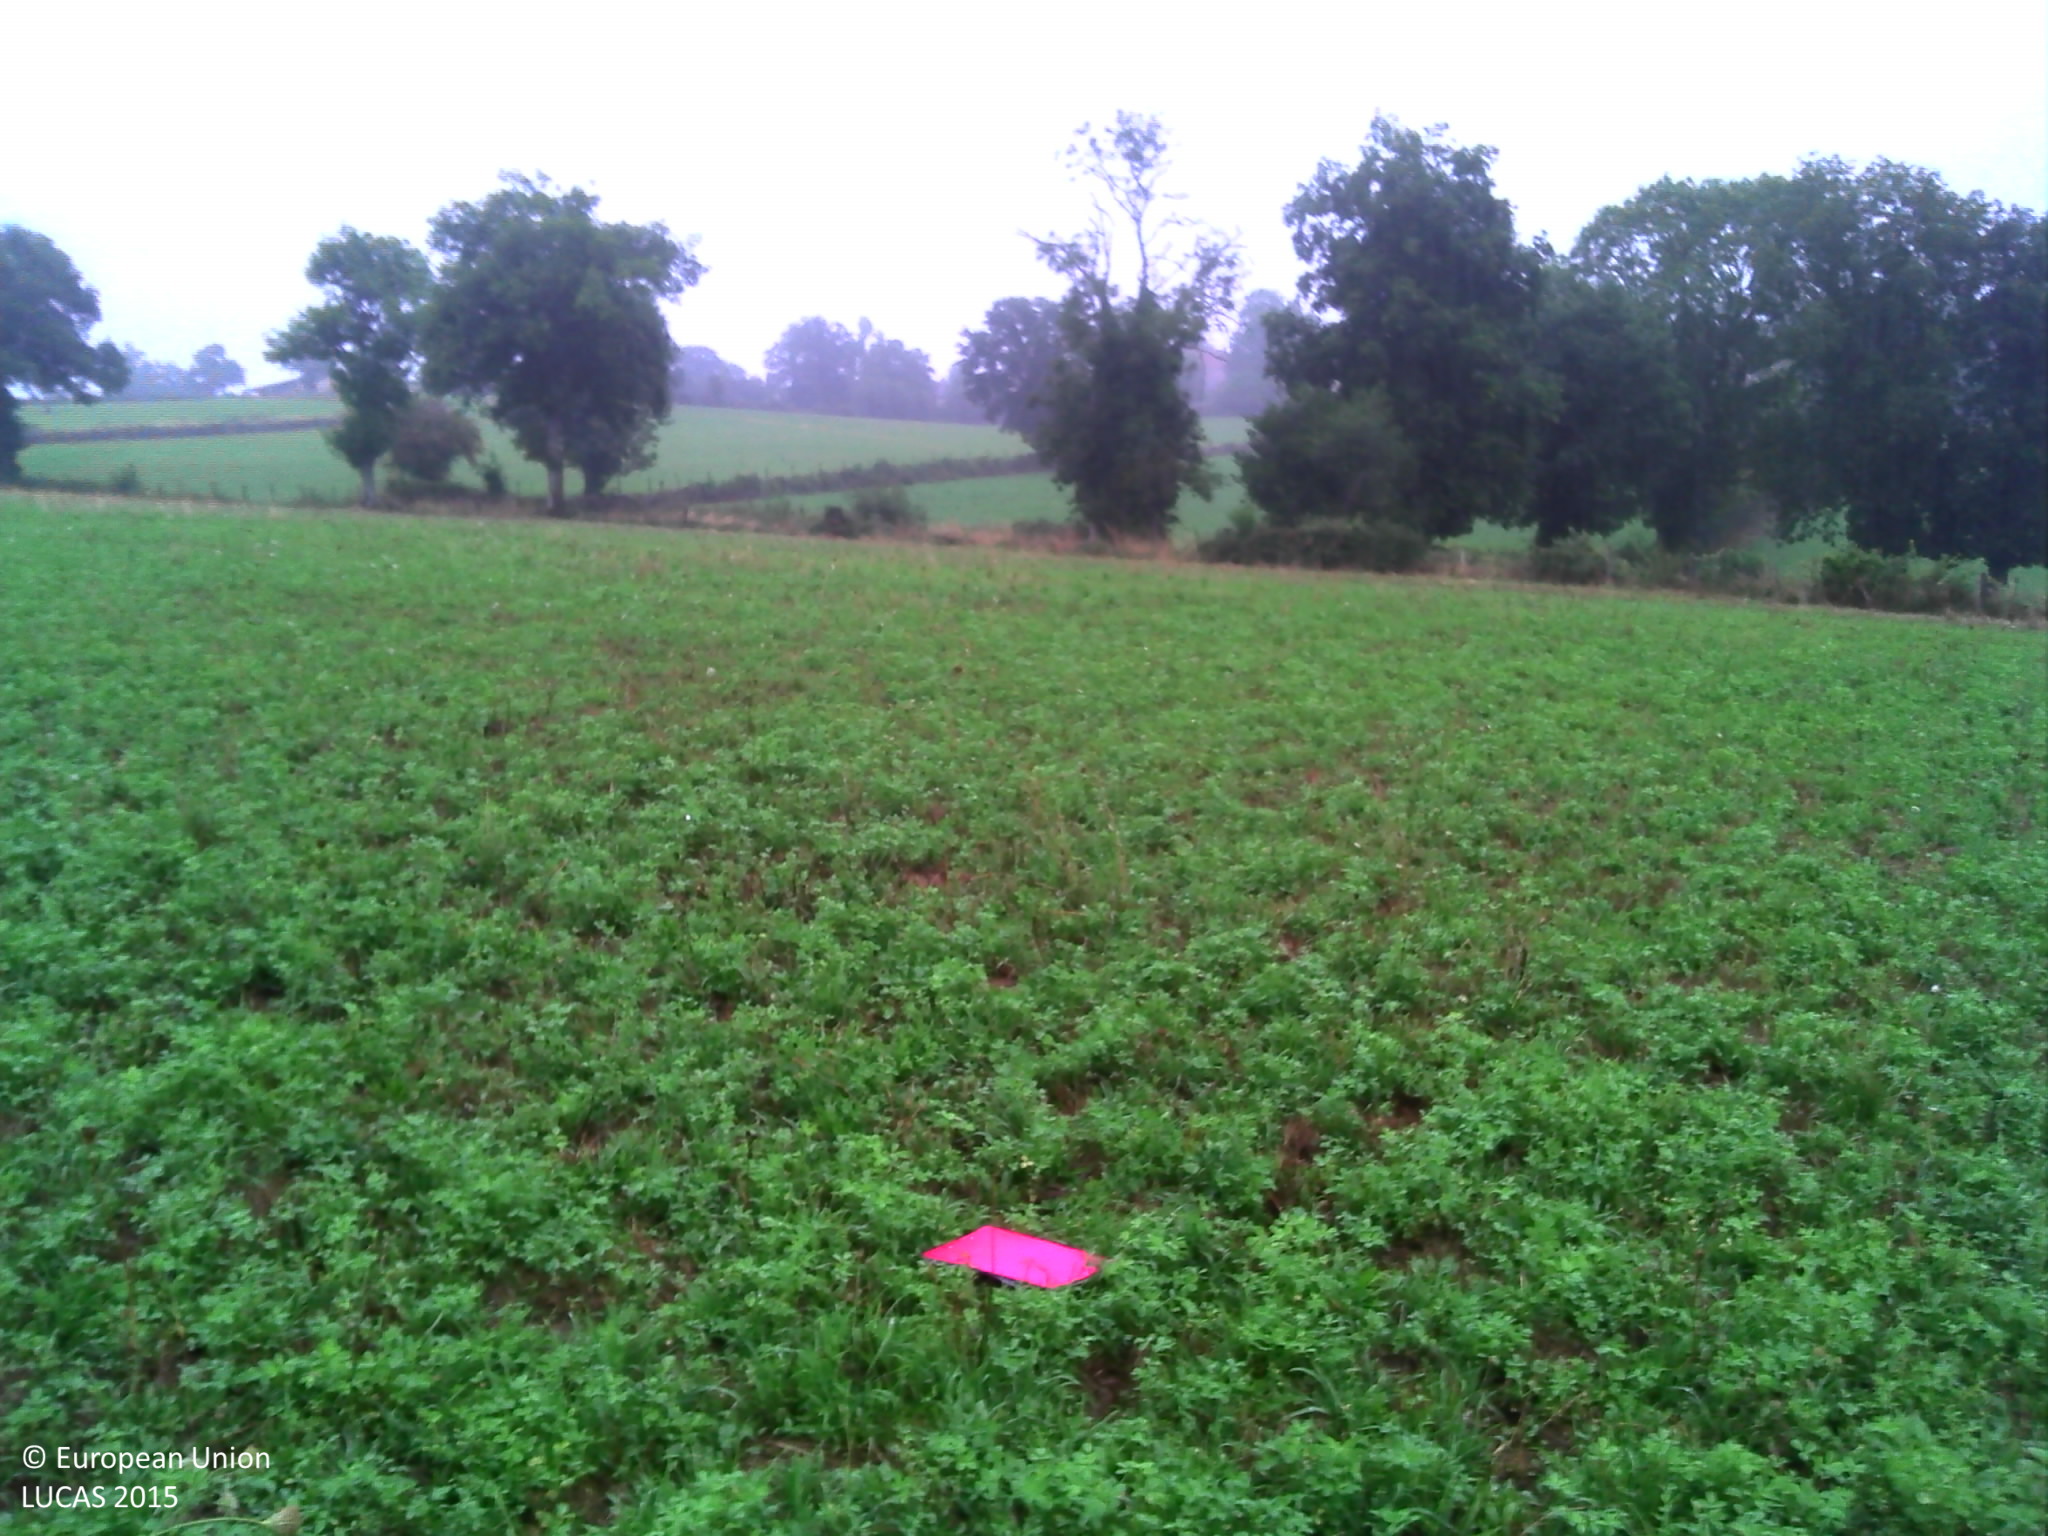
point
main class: Cropland
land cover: Lucerne
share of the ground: > 75 %
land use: Agriculture (excluding fallow land and kitchen gardens)
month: August
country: FR
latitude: 46.0754
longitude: 2.3282
